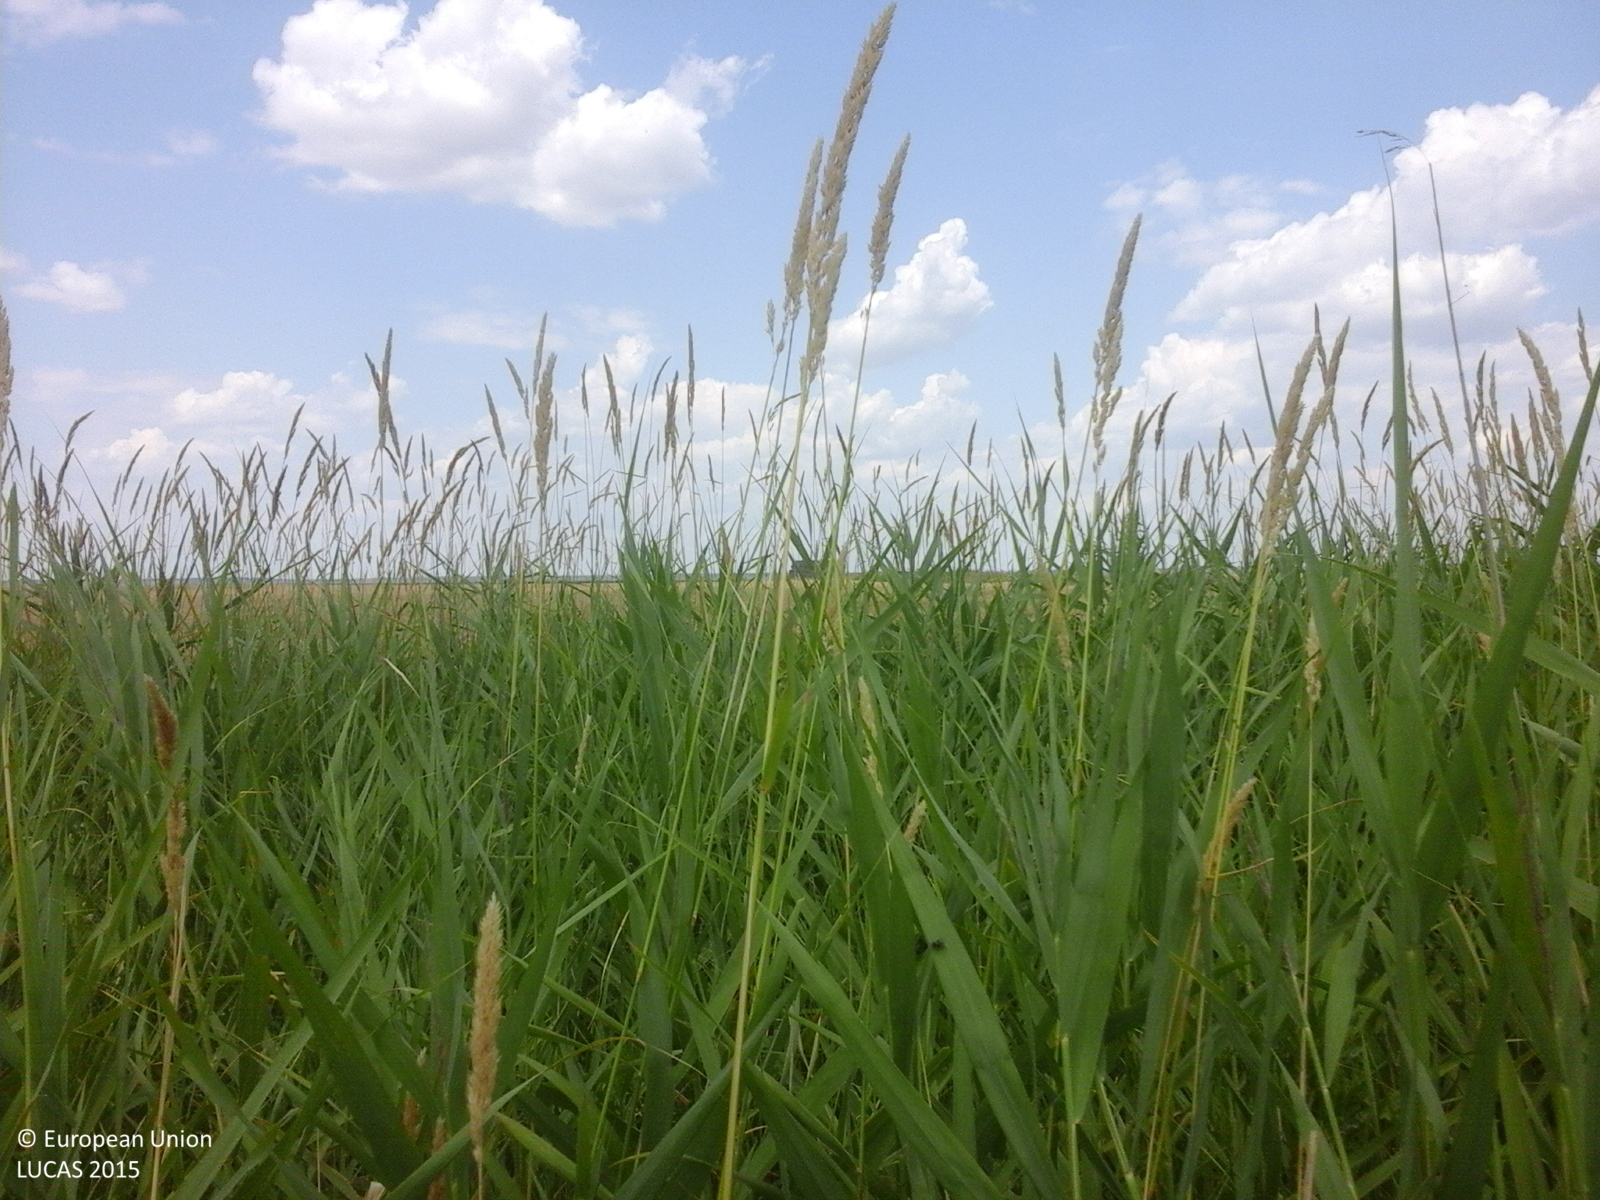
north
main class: Grassland
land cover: Spontaneously vegetated surfaces
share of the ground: > 75 %
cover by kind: herbaceous plants 100 %
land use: Fallow land
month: June
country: RO
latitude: 44.0617
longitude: 26.5279
